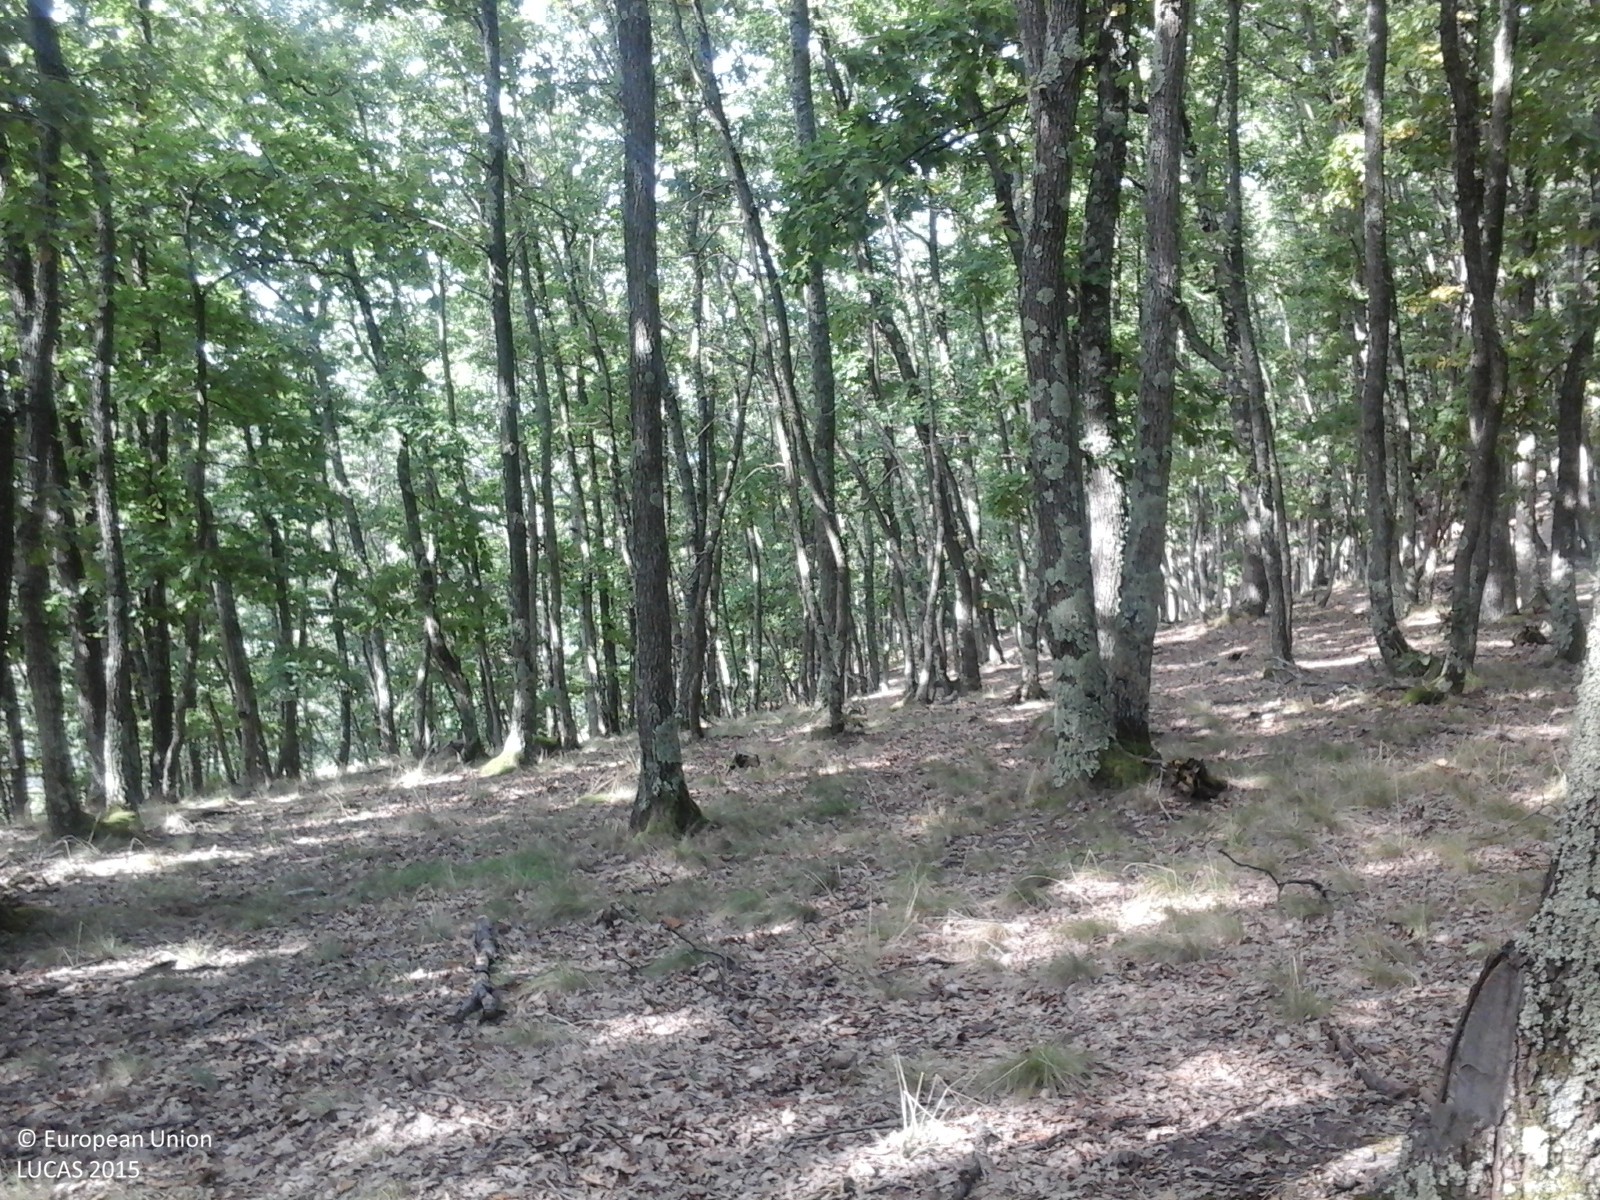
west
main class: Woodland
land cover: Broadleaved woodland
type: acidophilous oak and oak-birch forest
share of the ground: > 75 %
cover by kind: broadleaved forest trees 100 %
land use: Forestry
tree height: > 5 m
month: September
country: RO
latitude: 46.9861
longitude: 23.0663
